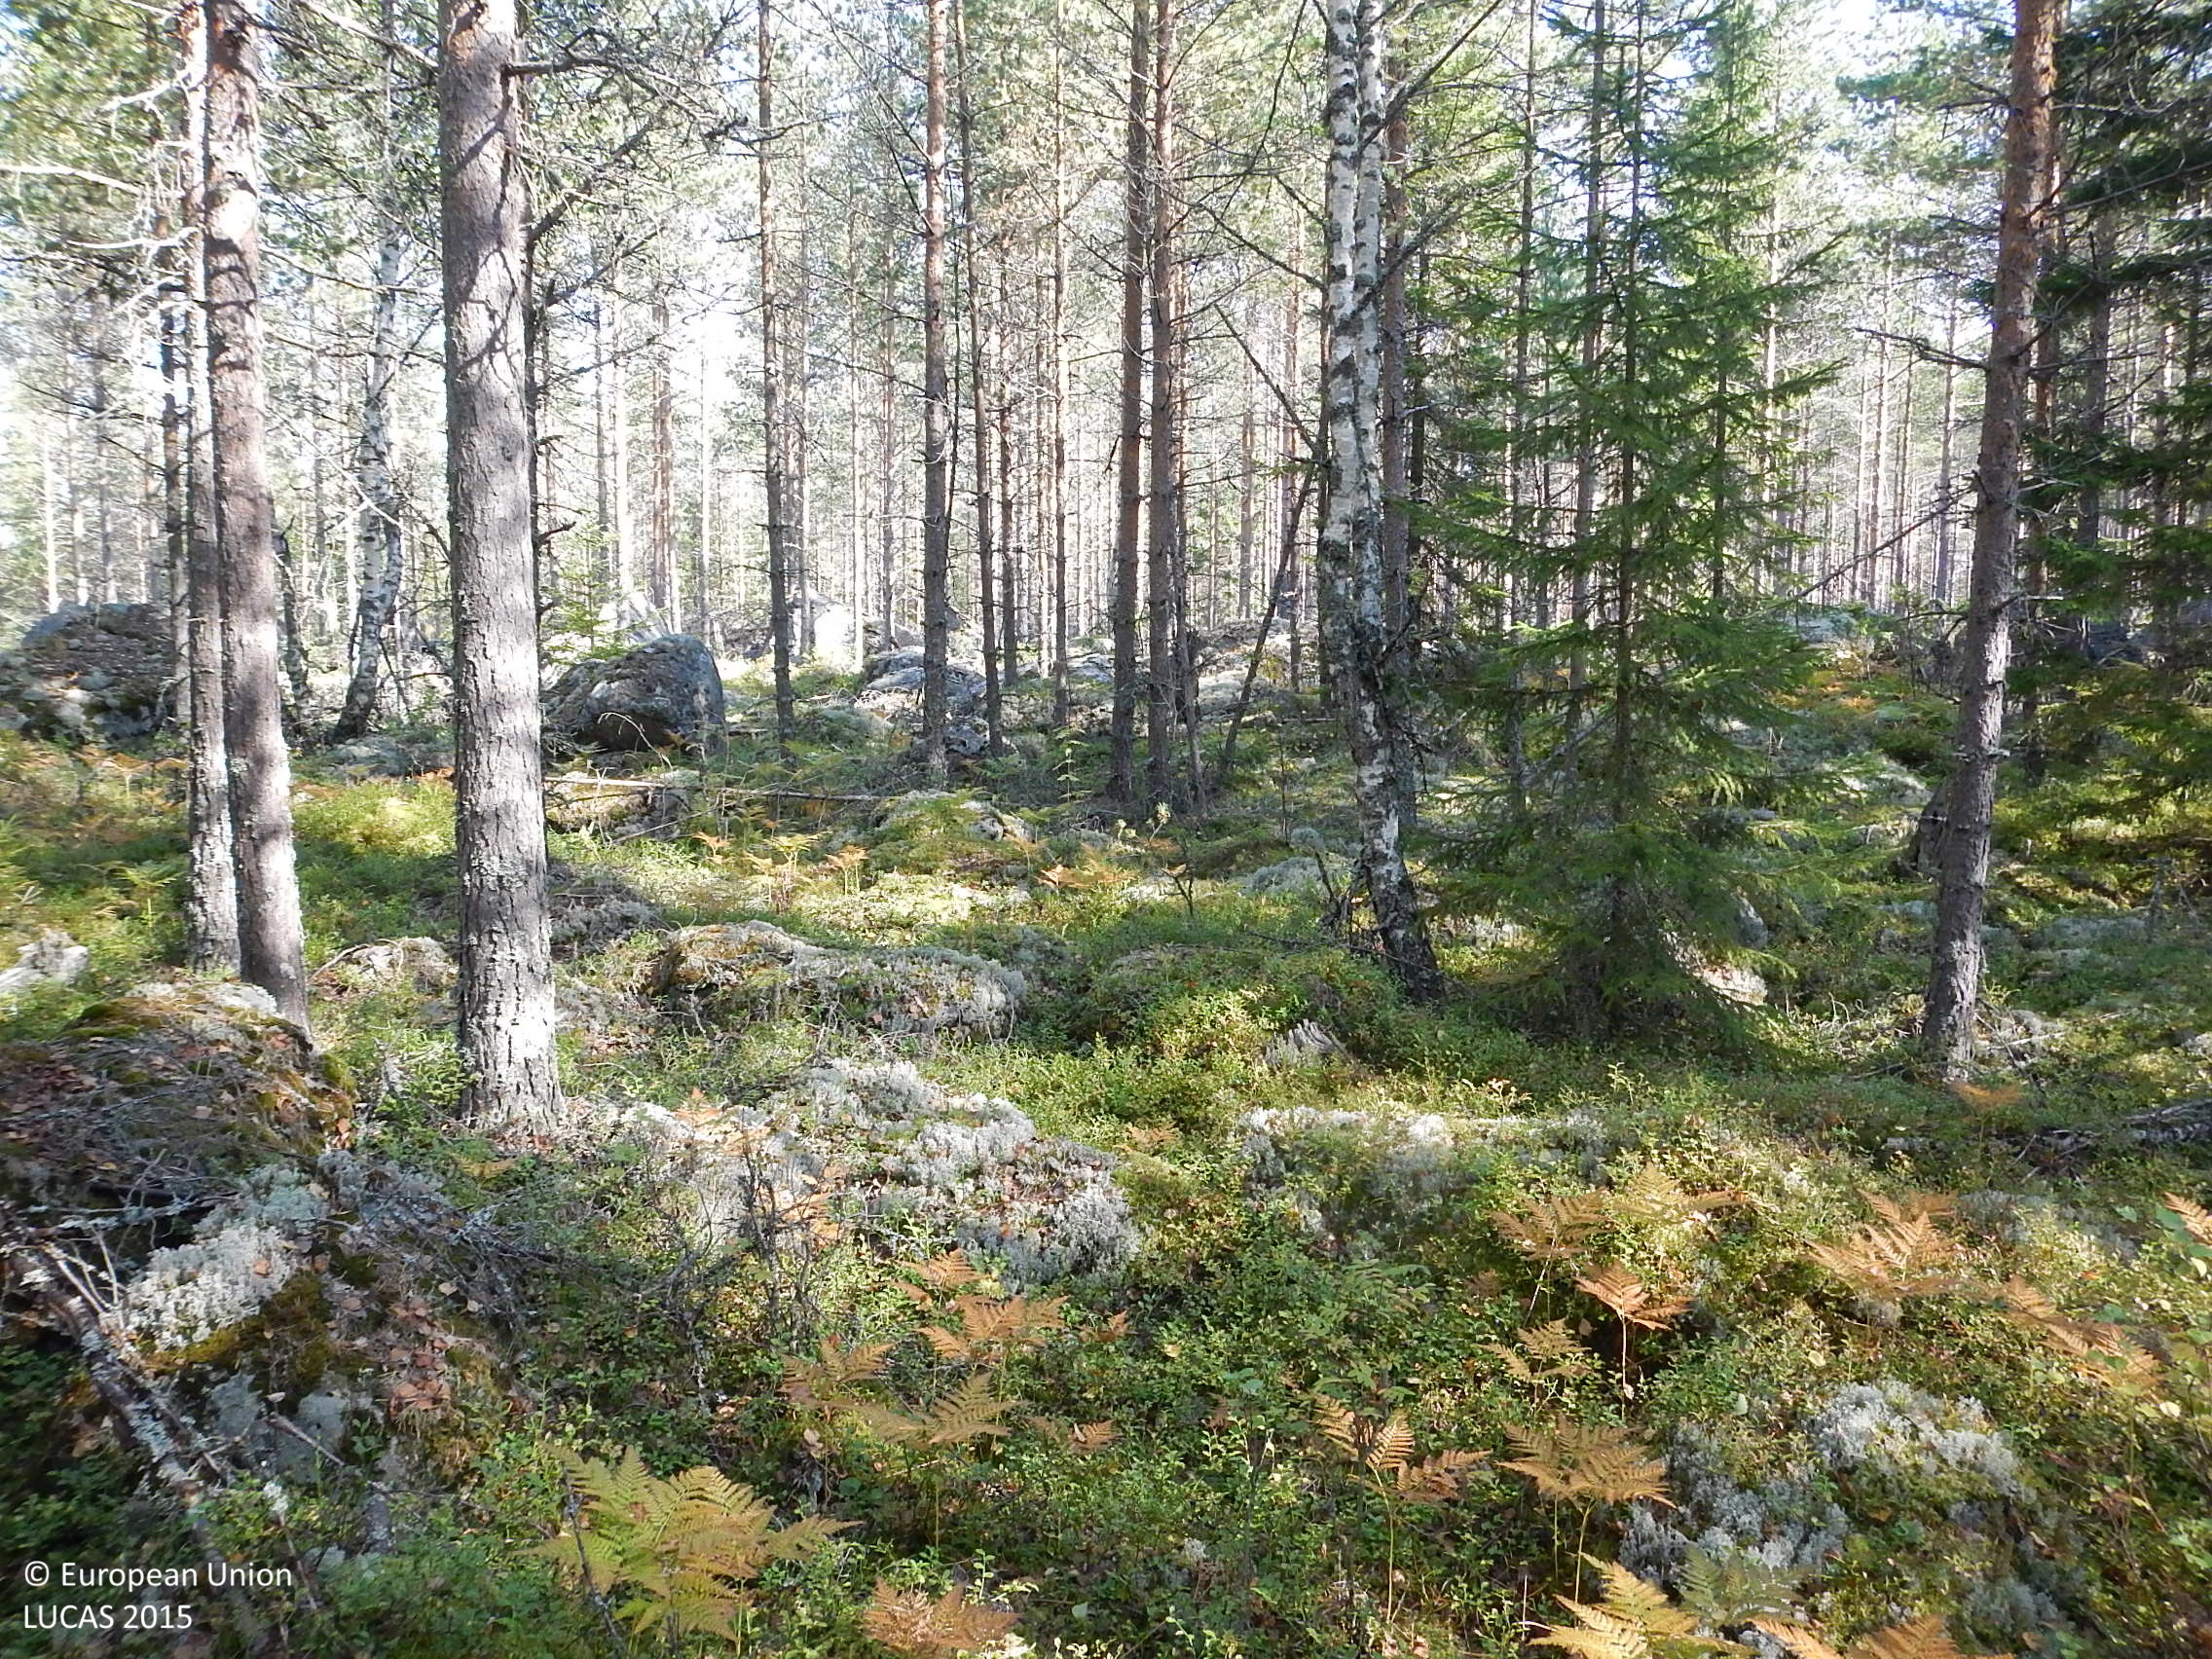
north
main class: Woodland
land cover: Other mixed woodland
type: boreal forest
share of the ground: > 75 %
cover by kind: coniferous forest trees 50 %, broadleaved forest trees 25 %, shrubs 20 %, lichens and mosses 5 %
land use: Forestry
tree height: > 5 m
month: September
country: FI
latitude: 61.5865
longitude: 22.1717
